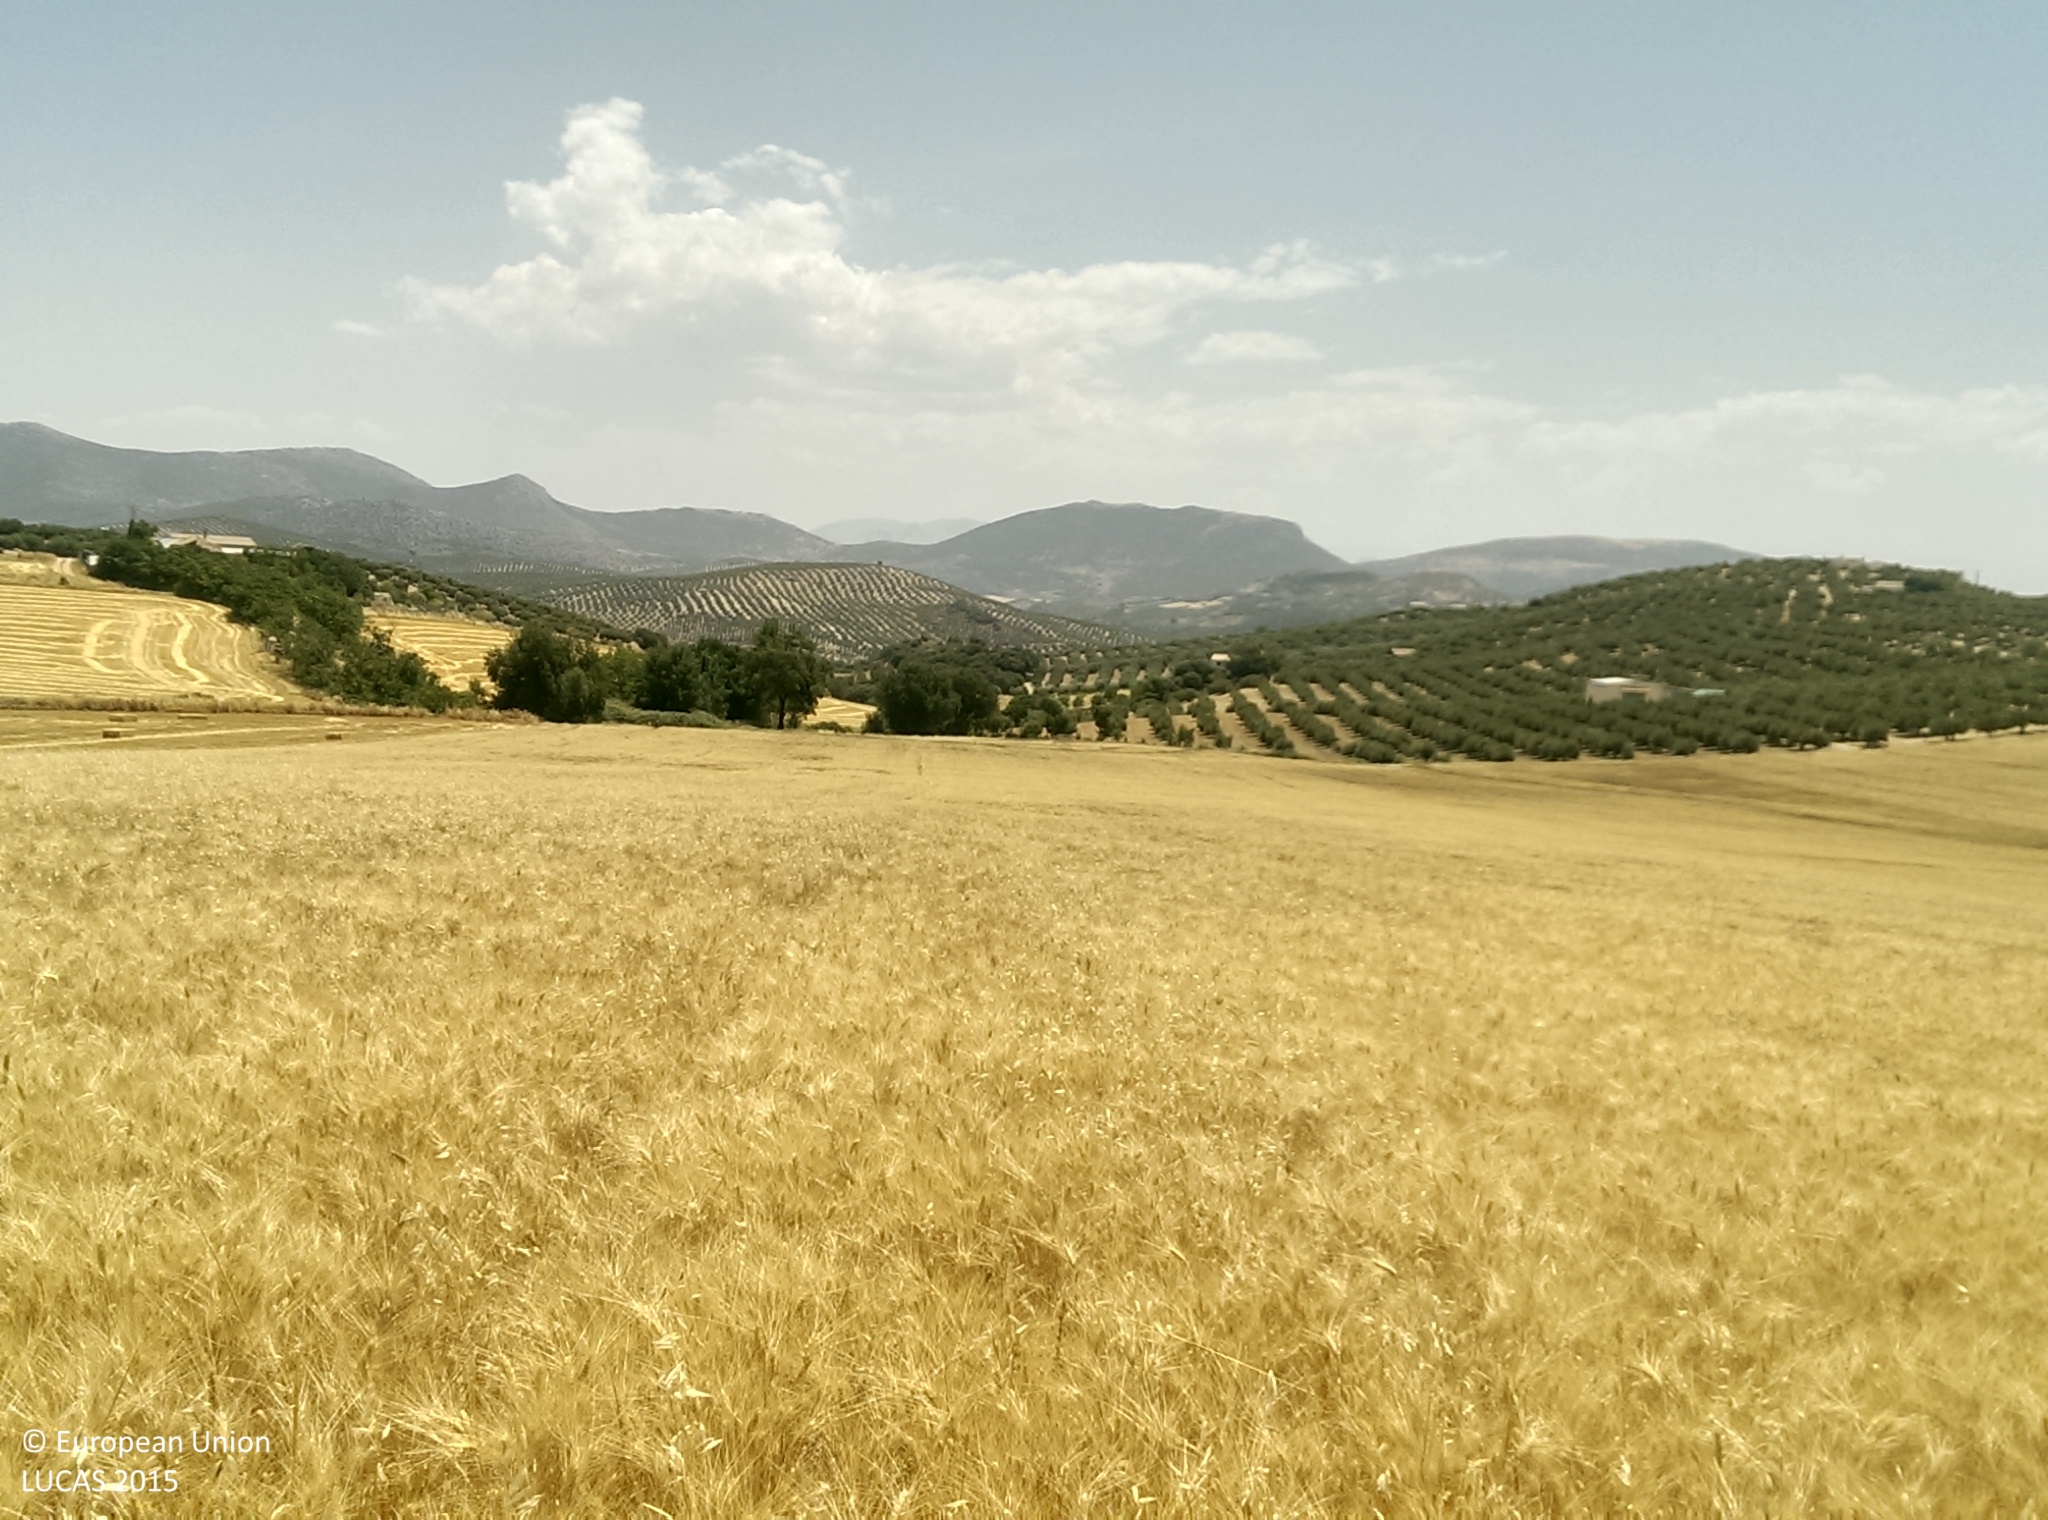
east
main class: Cropland
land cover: Common wheat
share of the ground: > 75 %
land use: Agriculture (excluding fallow land and kitchen gardens)
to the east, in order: Common wheat; Grass margins; Rivers and streams; Grass margins; Common wheat
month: July
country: ES
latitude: 37.4235
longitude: -3.7468
